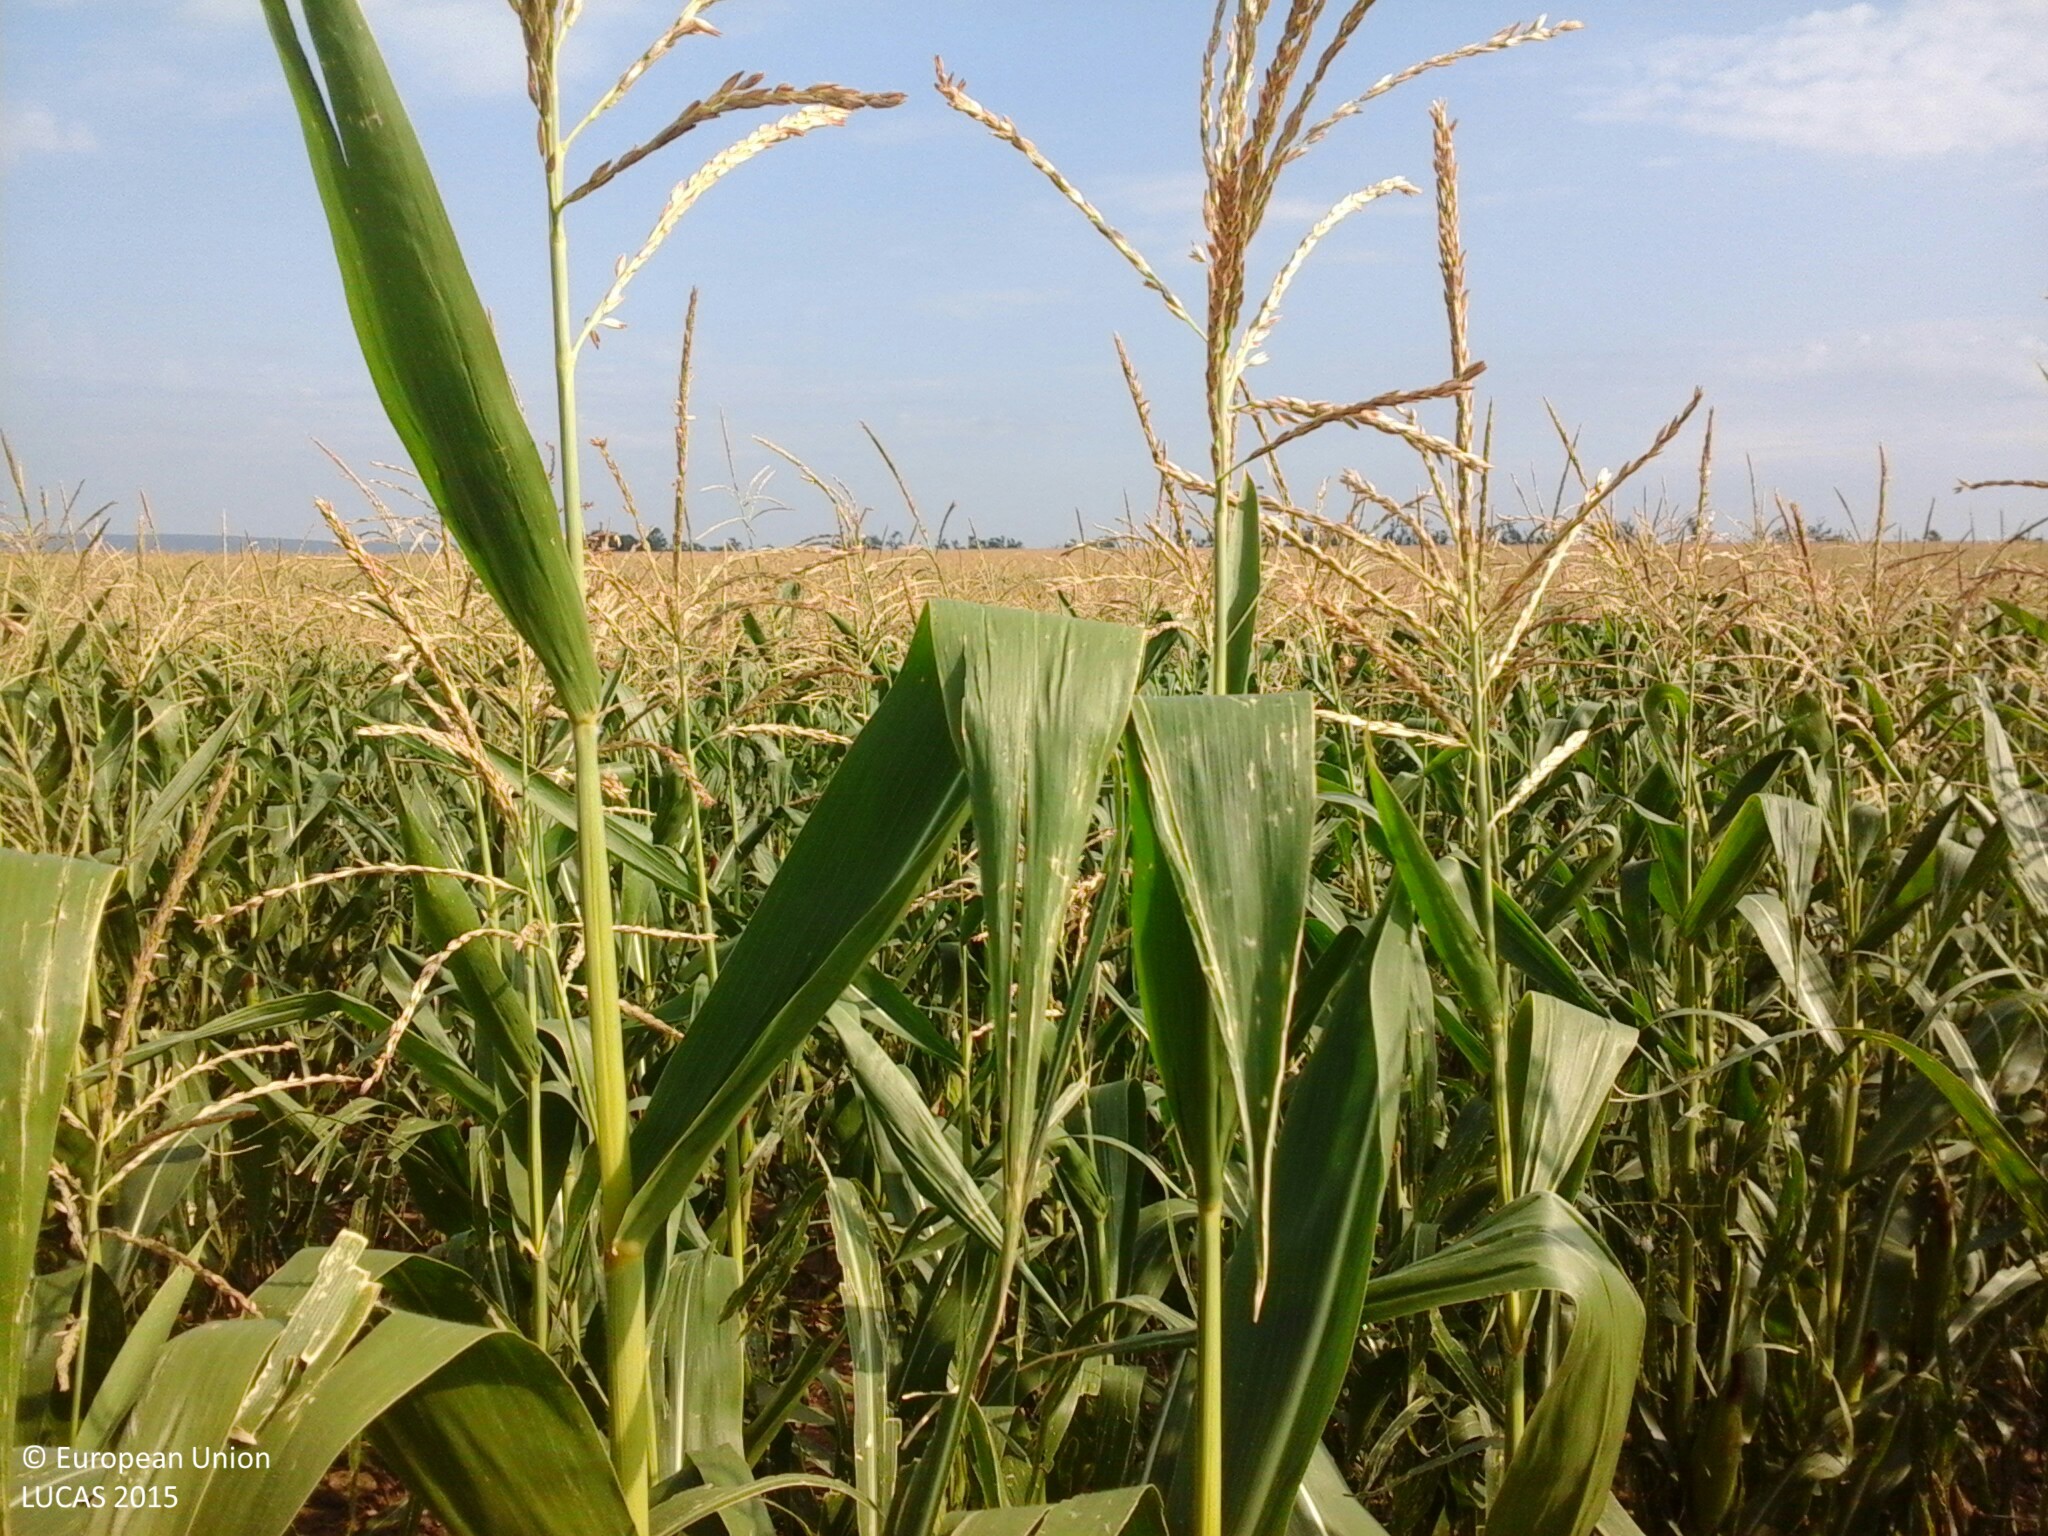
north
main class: Cropland
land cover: Maize
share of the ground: > 75 %
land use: Agriculture (excluding fallow land and kitchen gardens)
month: August
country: HU
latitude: 47.2888
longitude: 18.3822
